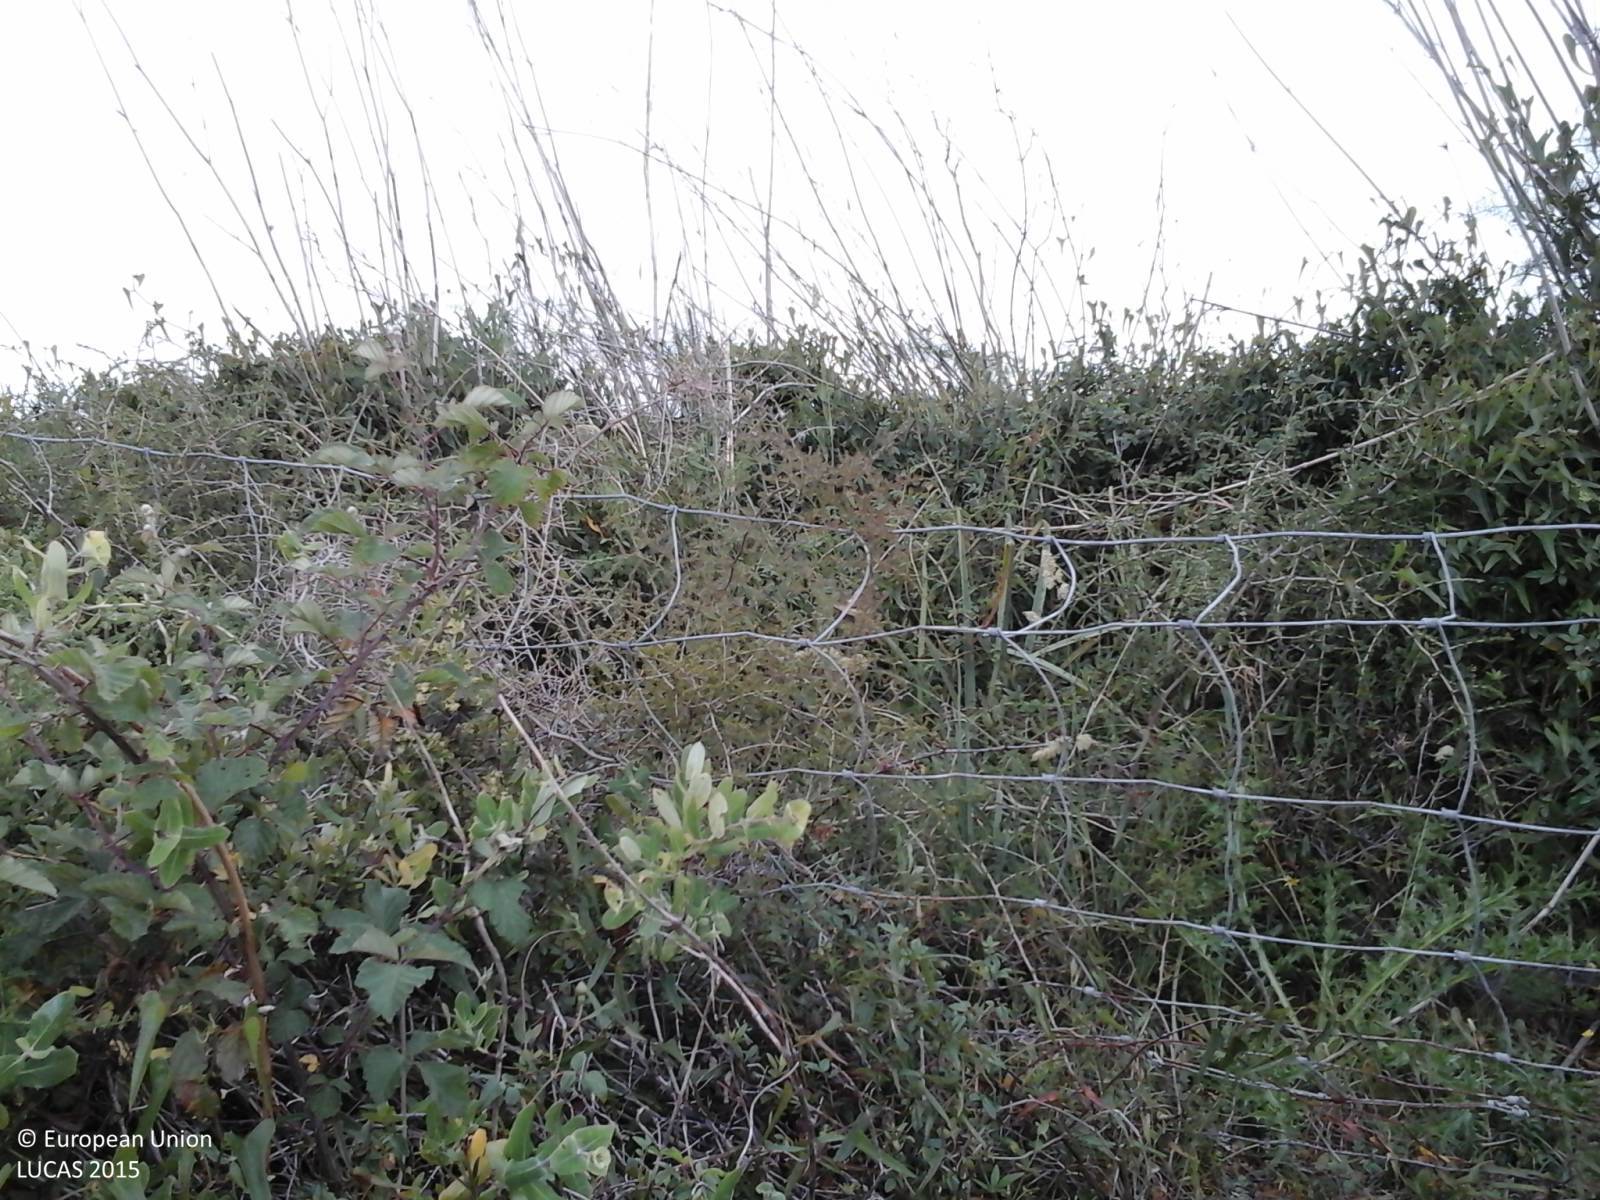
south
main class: Grassland
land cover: Grassland without tree/shrub cover
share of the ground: > 75 %
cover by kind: herbaceous plants 95 %, shrubs 5 %
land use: Agriculture (excluding fallow land and kitchen gardens)
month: May
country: IT
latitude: 39.7530
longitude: 8.8047
